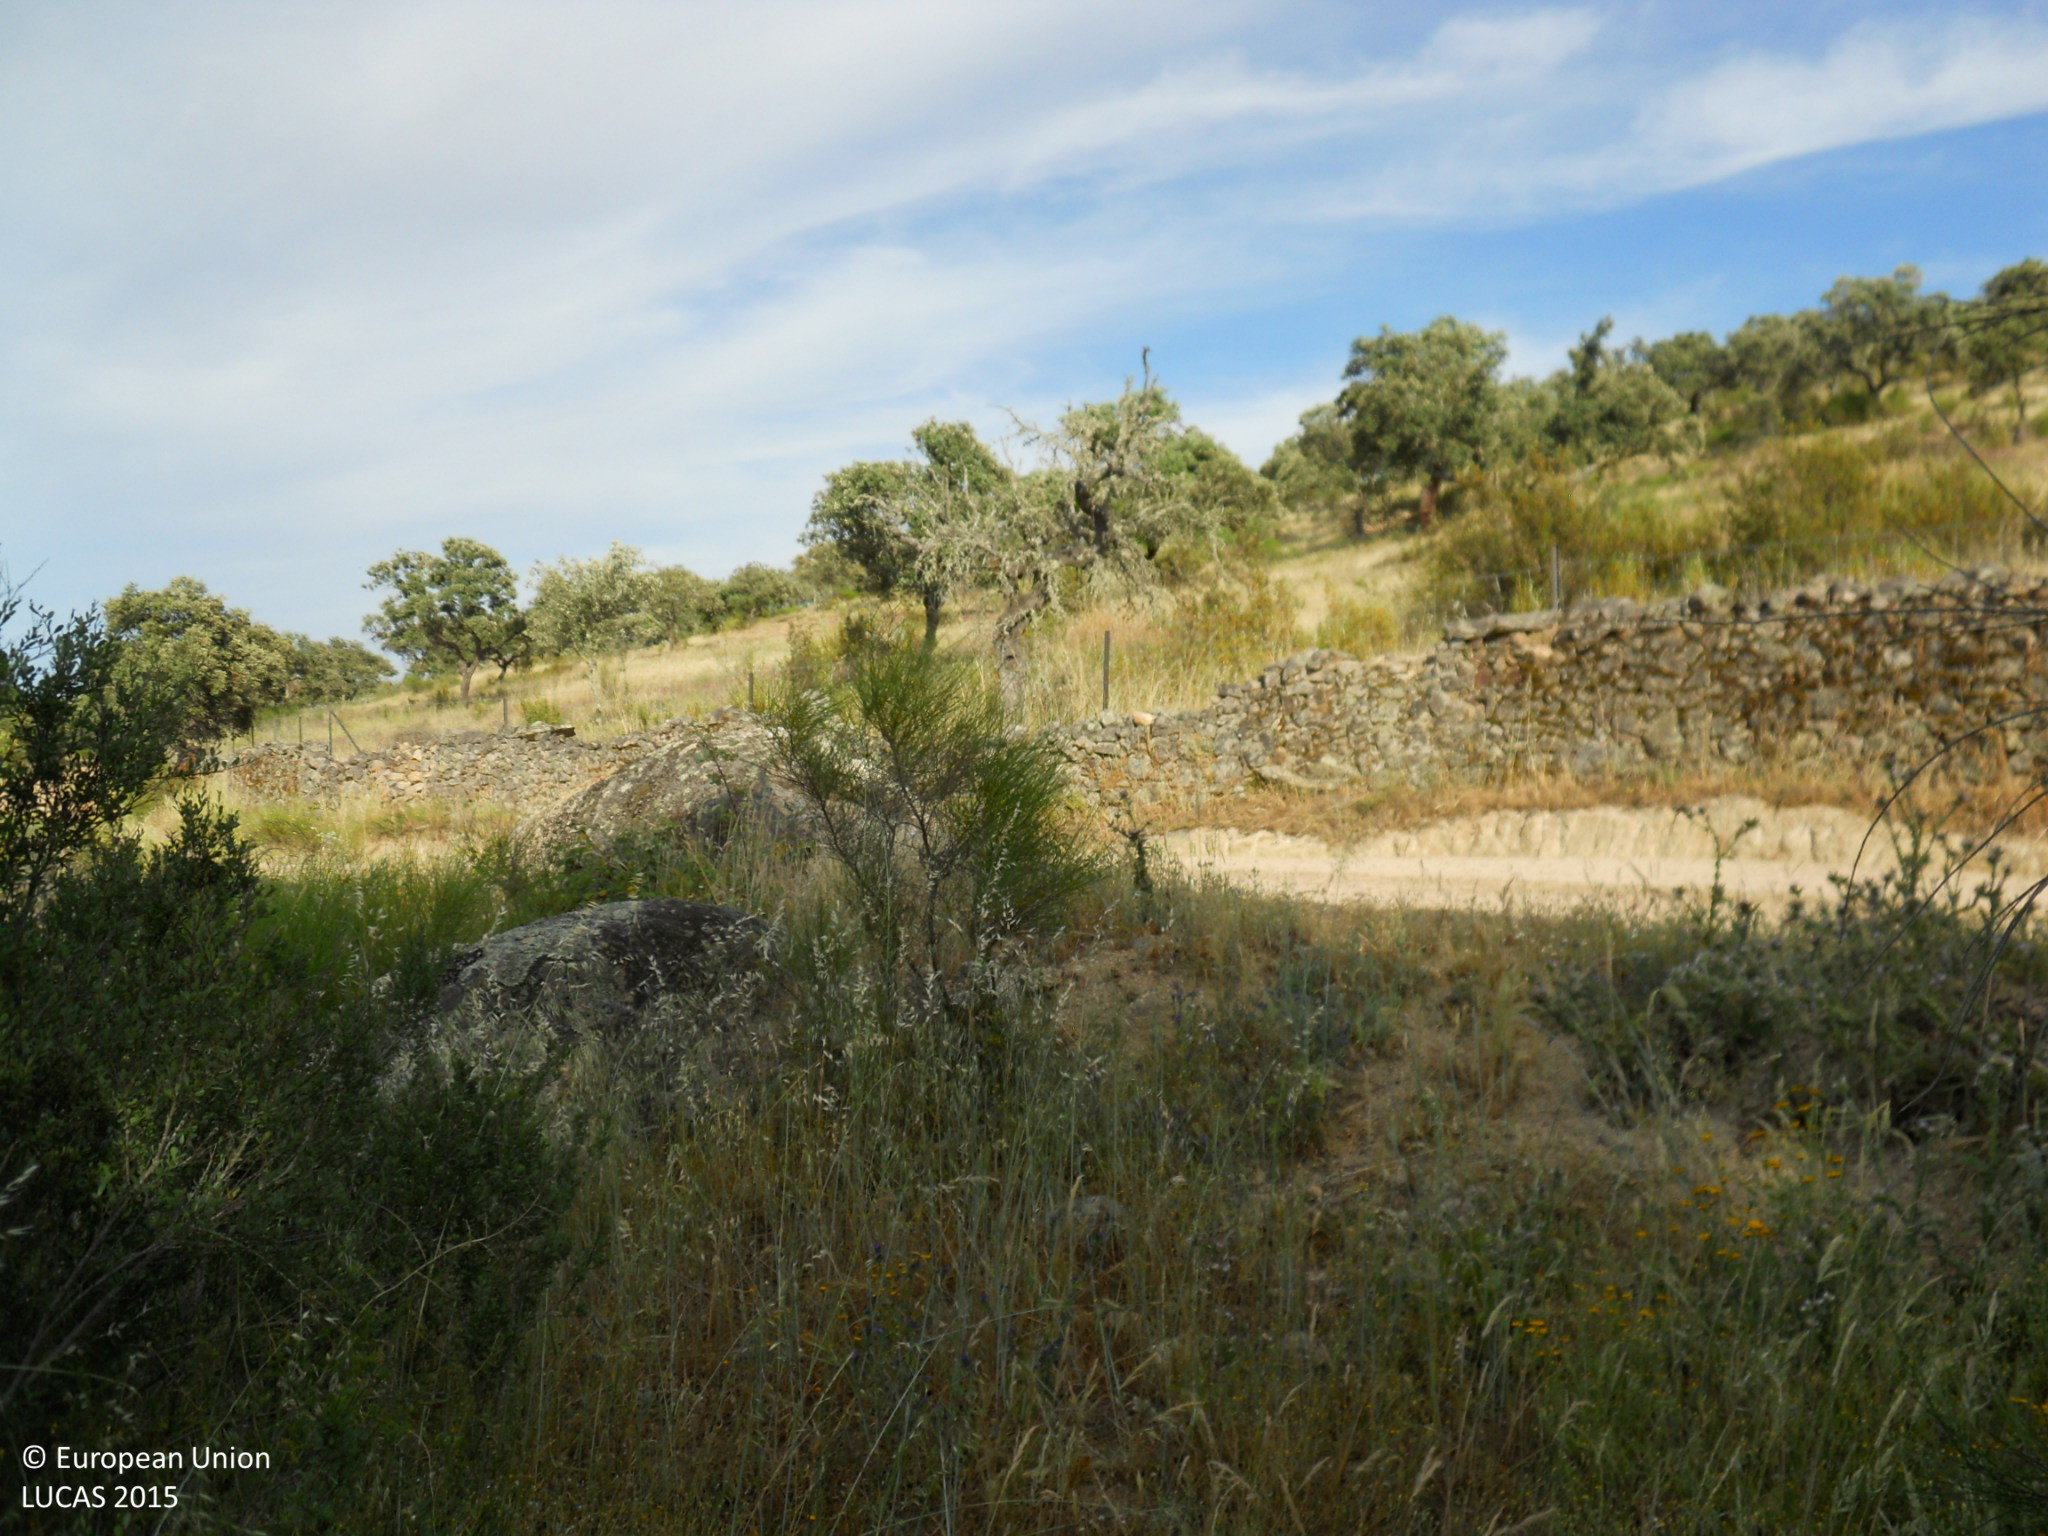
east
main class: Shrubland
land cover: Shrubland with sparse tree cover
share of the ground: > 75 %
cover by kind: shrubs 80 %, herbaceous plants 10 %, broadleaved forest trees 5 %, consolidated bare surface 5 %
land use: Agriculture (excluding fallow land and kitchen gardens)
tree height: > 5 m
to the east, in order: Shrubland with sparse tree cover; Electric lines; Rock outcrops; Tracks; Dry stone walls; Fences; Shrubland with sparse tree cover; Broadleaved woodland
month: May
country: ES
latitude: 39.0602
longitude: -6.2962
